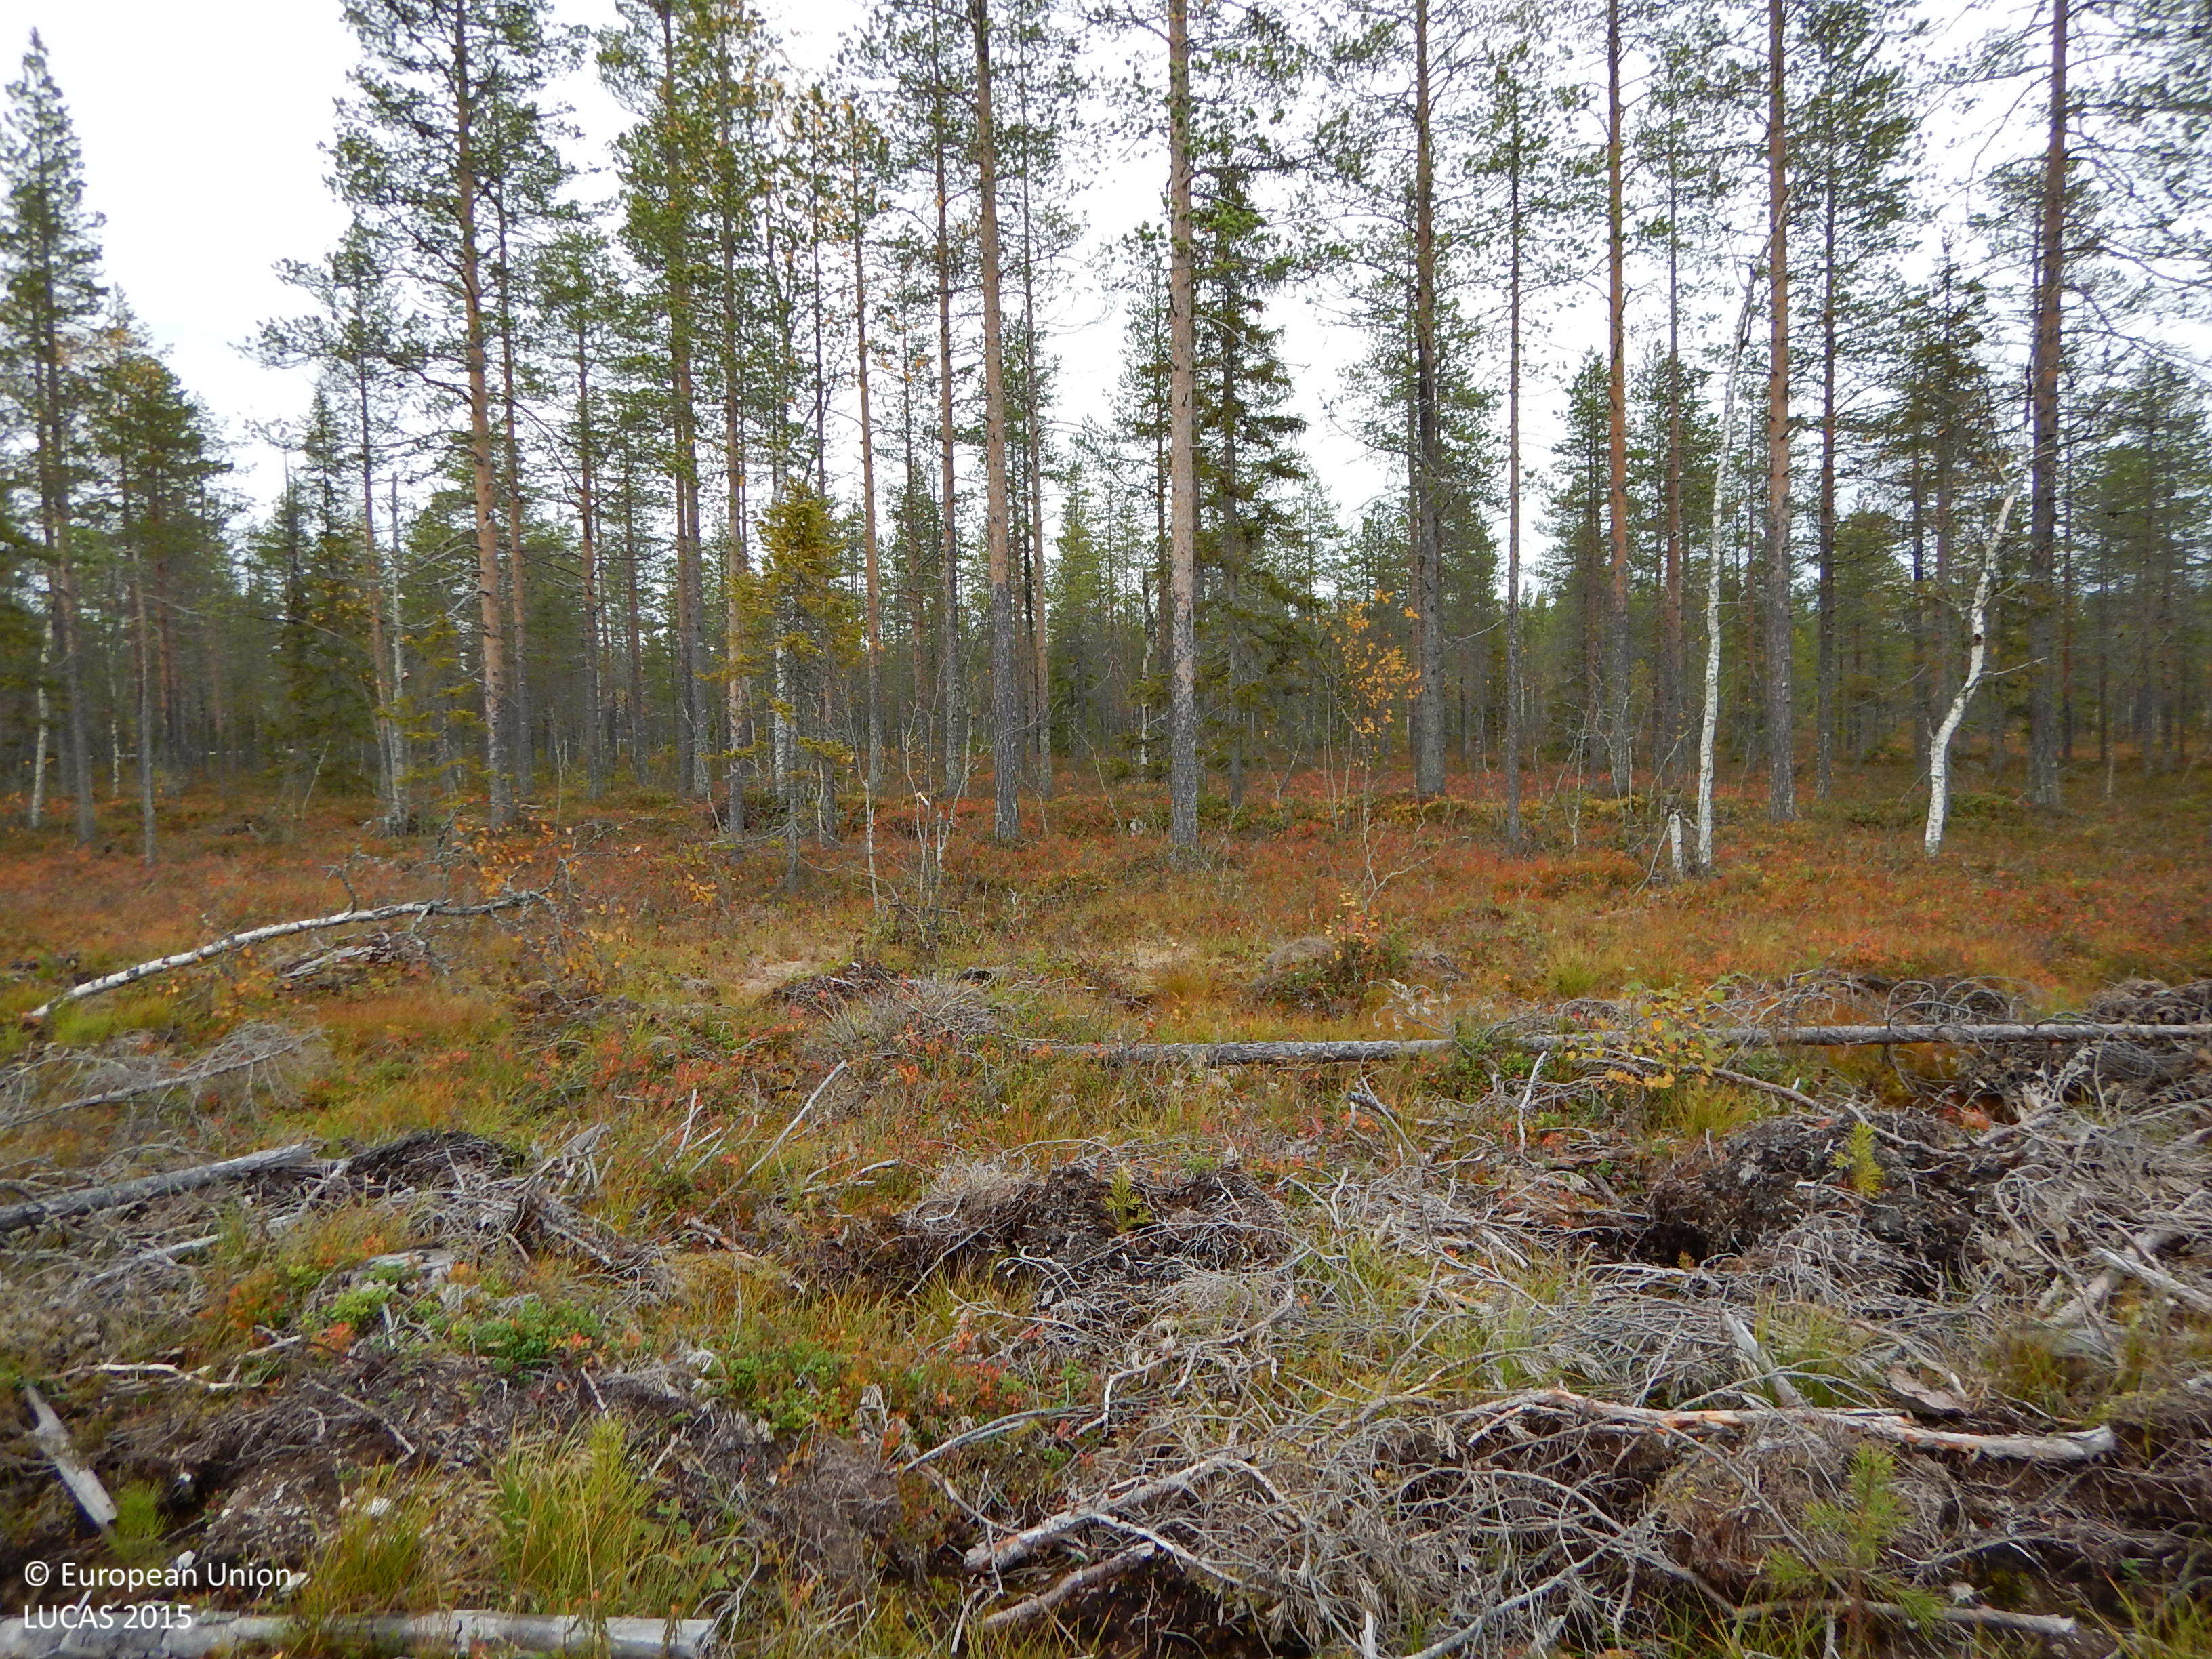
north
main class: Shrubland
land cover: Shrubland with sparse tree cover
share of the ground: 50 - 75 %
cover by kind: shrubs 40 %, herbaceous plants 40 %, lichens and mosses 15 %, coniferous forest trees 5 %
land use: Forestry
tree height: < 5 m
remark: Clear cut
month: September
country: SE
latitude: 65.0316
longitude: 20.2679
